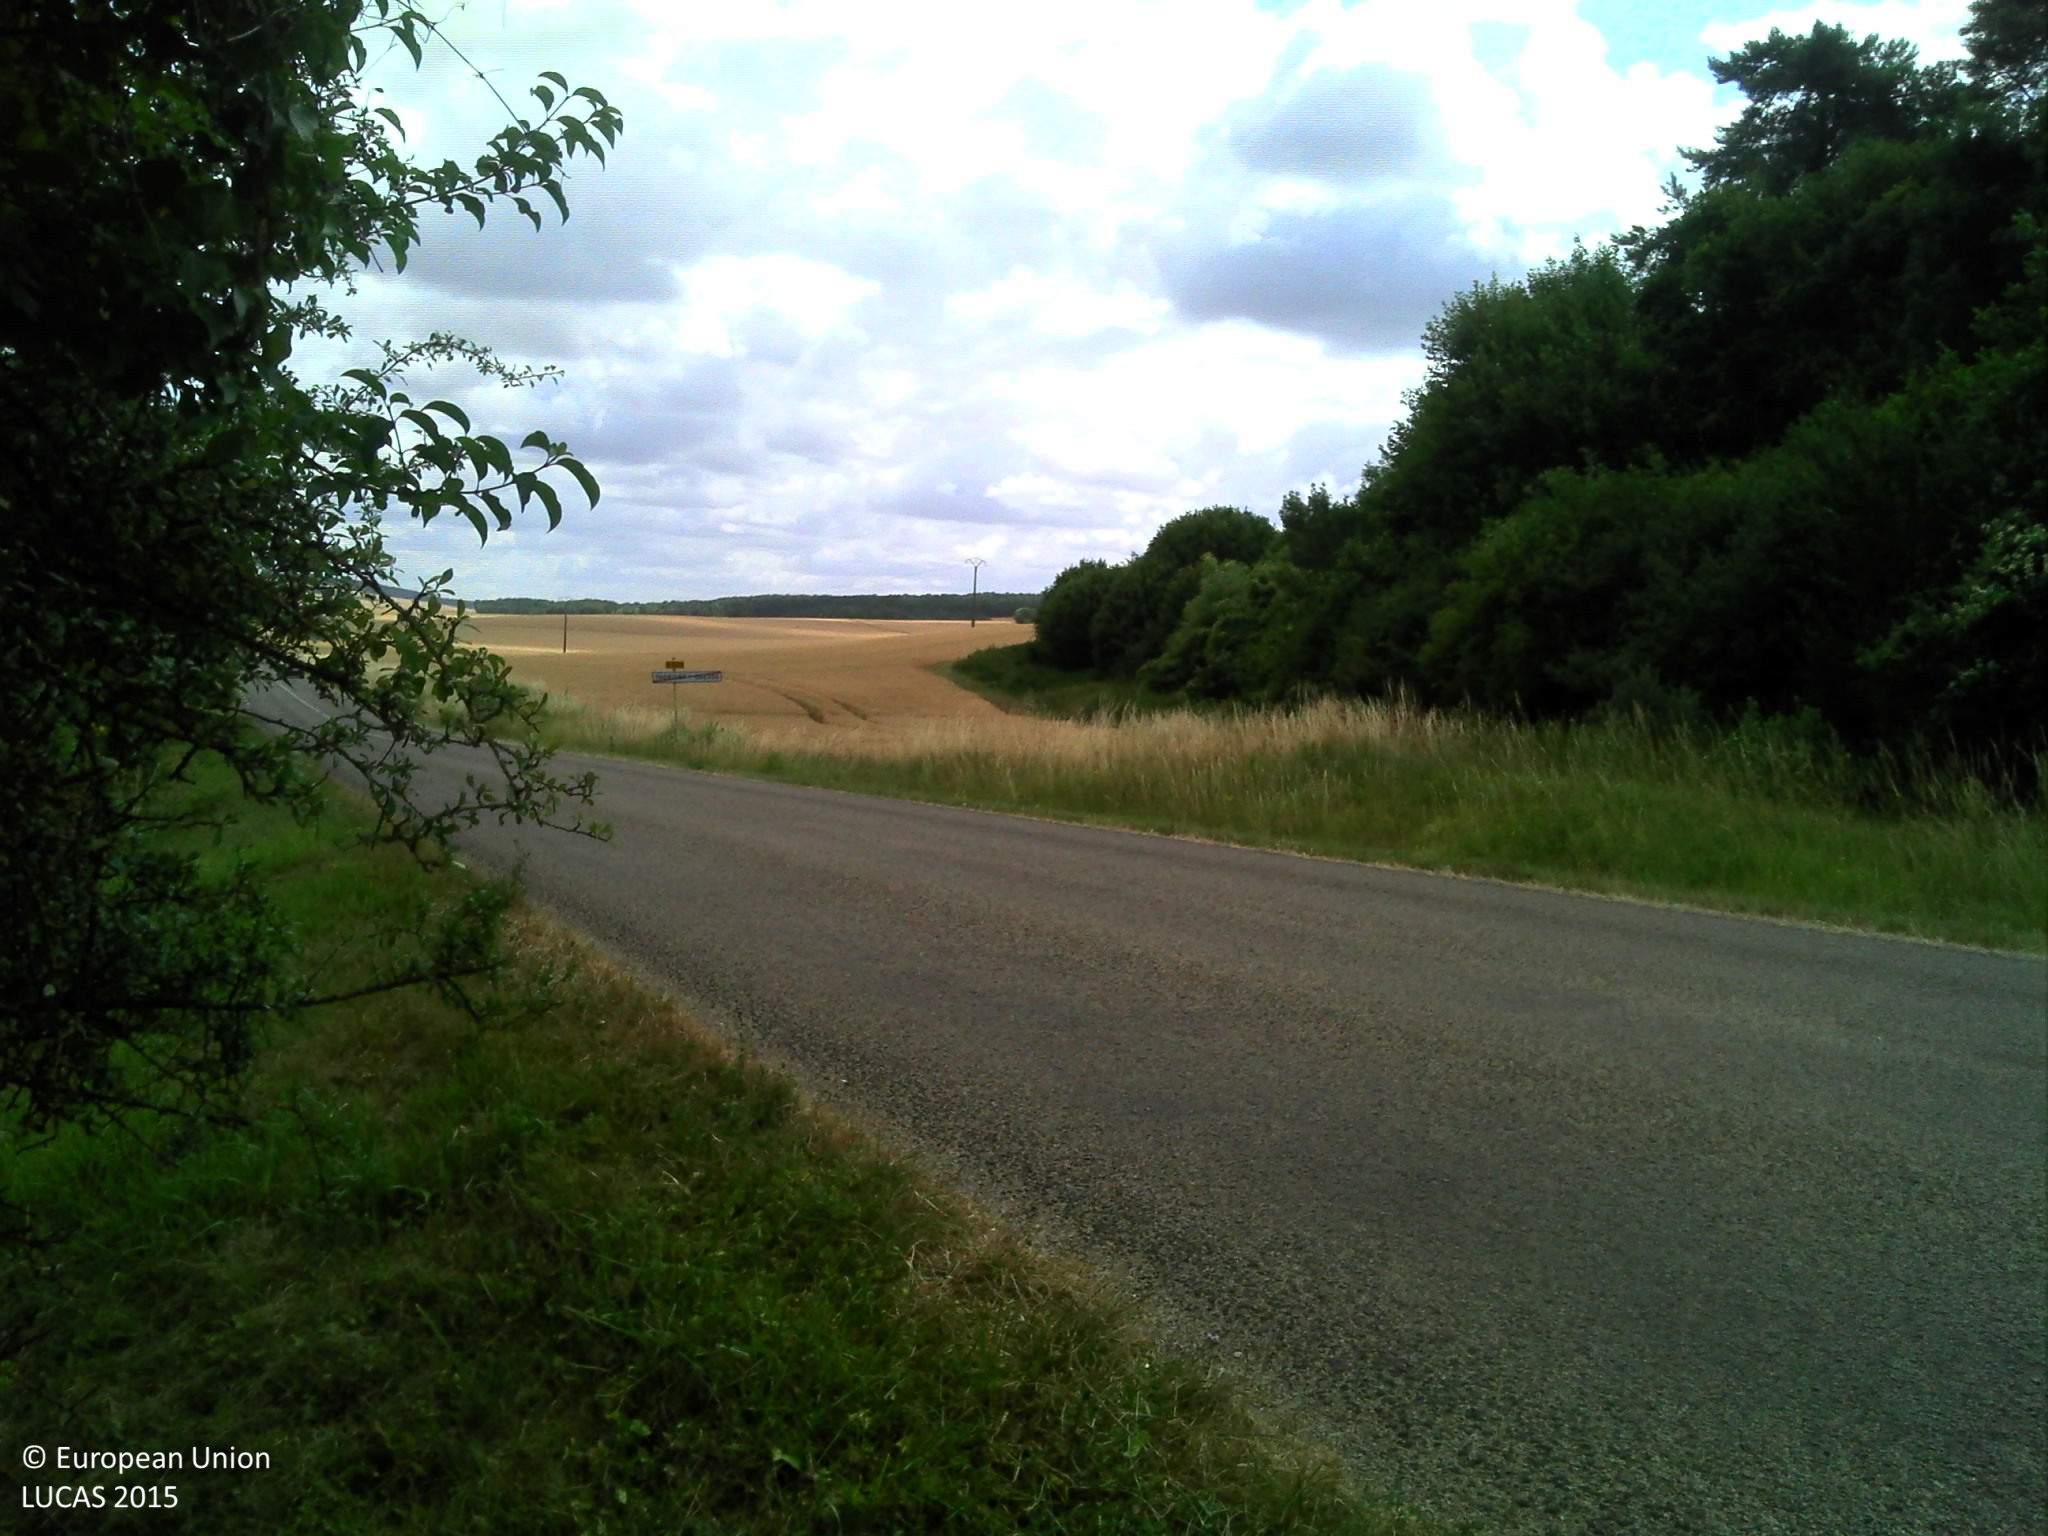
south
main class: Grassland
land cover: Grassland with sparse tree/shrub cover
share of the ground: > 75 %
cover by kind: herbaceous plants 90 %, broadleaved forest trees 5 %, shrubs 5 %
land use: Agriculture (excluding fallow land and kitchen gardens)
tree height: > 5 m
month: July
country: FR
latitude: 48.2967
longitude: 3.4023
